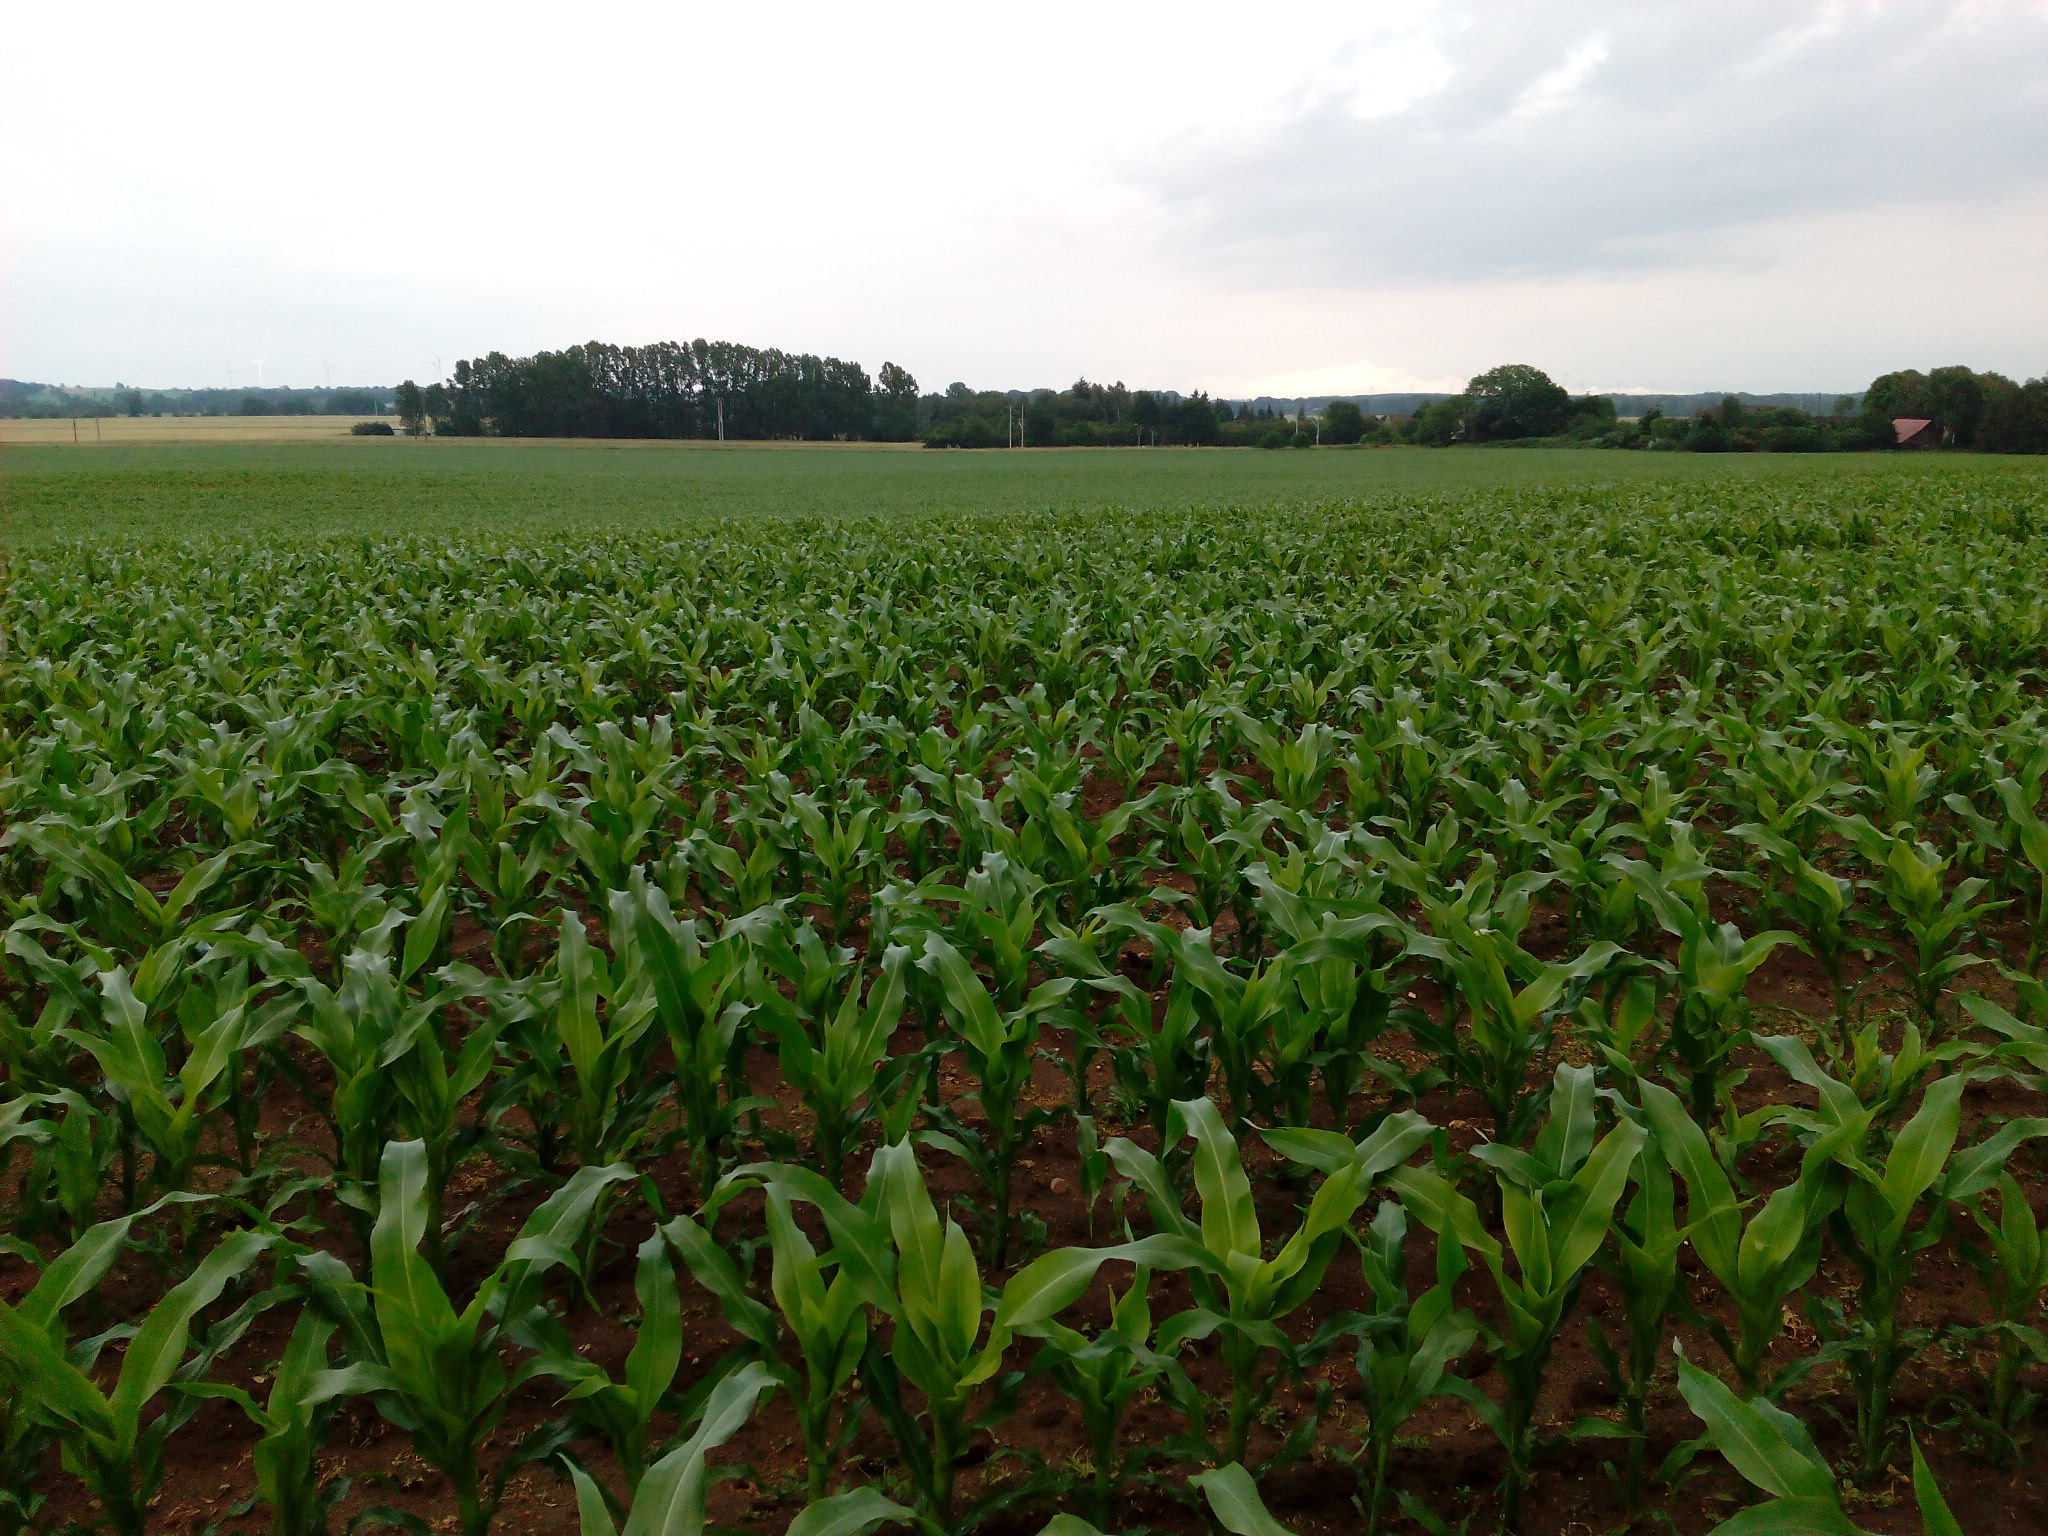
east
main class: Cropland
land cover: Maize
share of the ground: > 75 %
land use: Agriculture (excluding fallow land and kitchen gardens)
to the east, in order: Maize
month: June
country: DE
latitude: 52.9468
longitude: 13.1697
